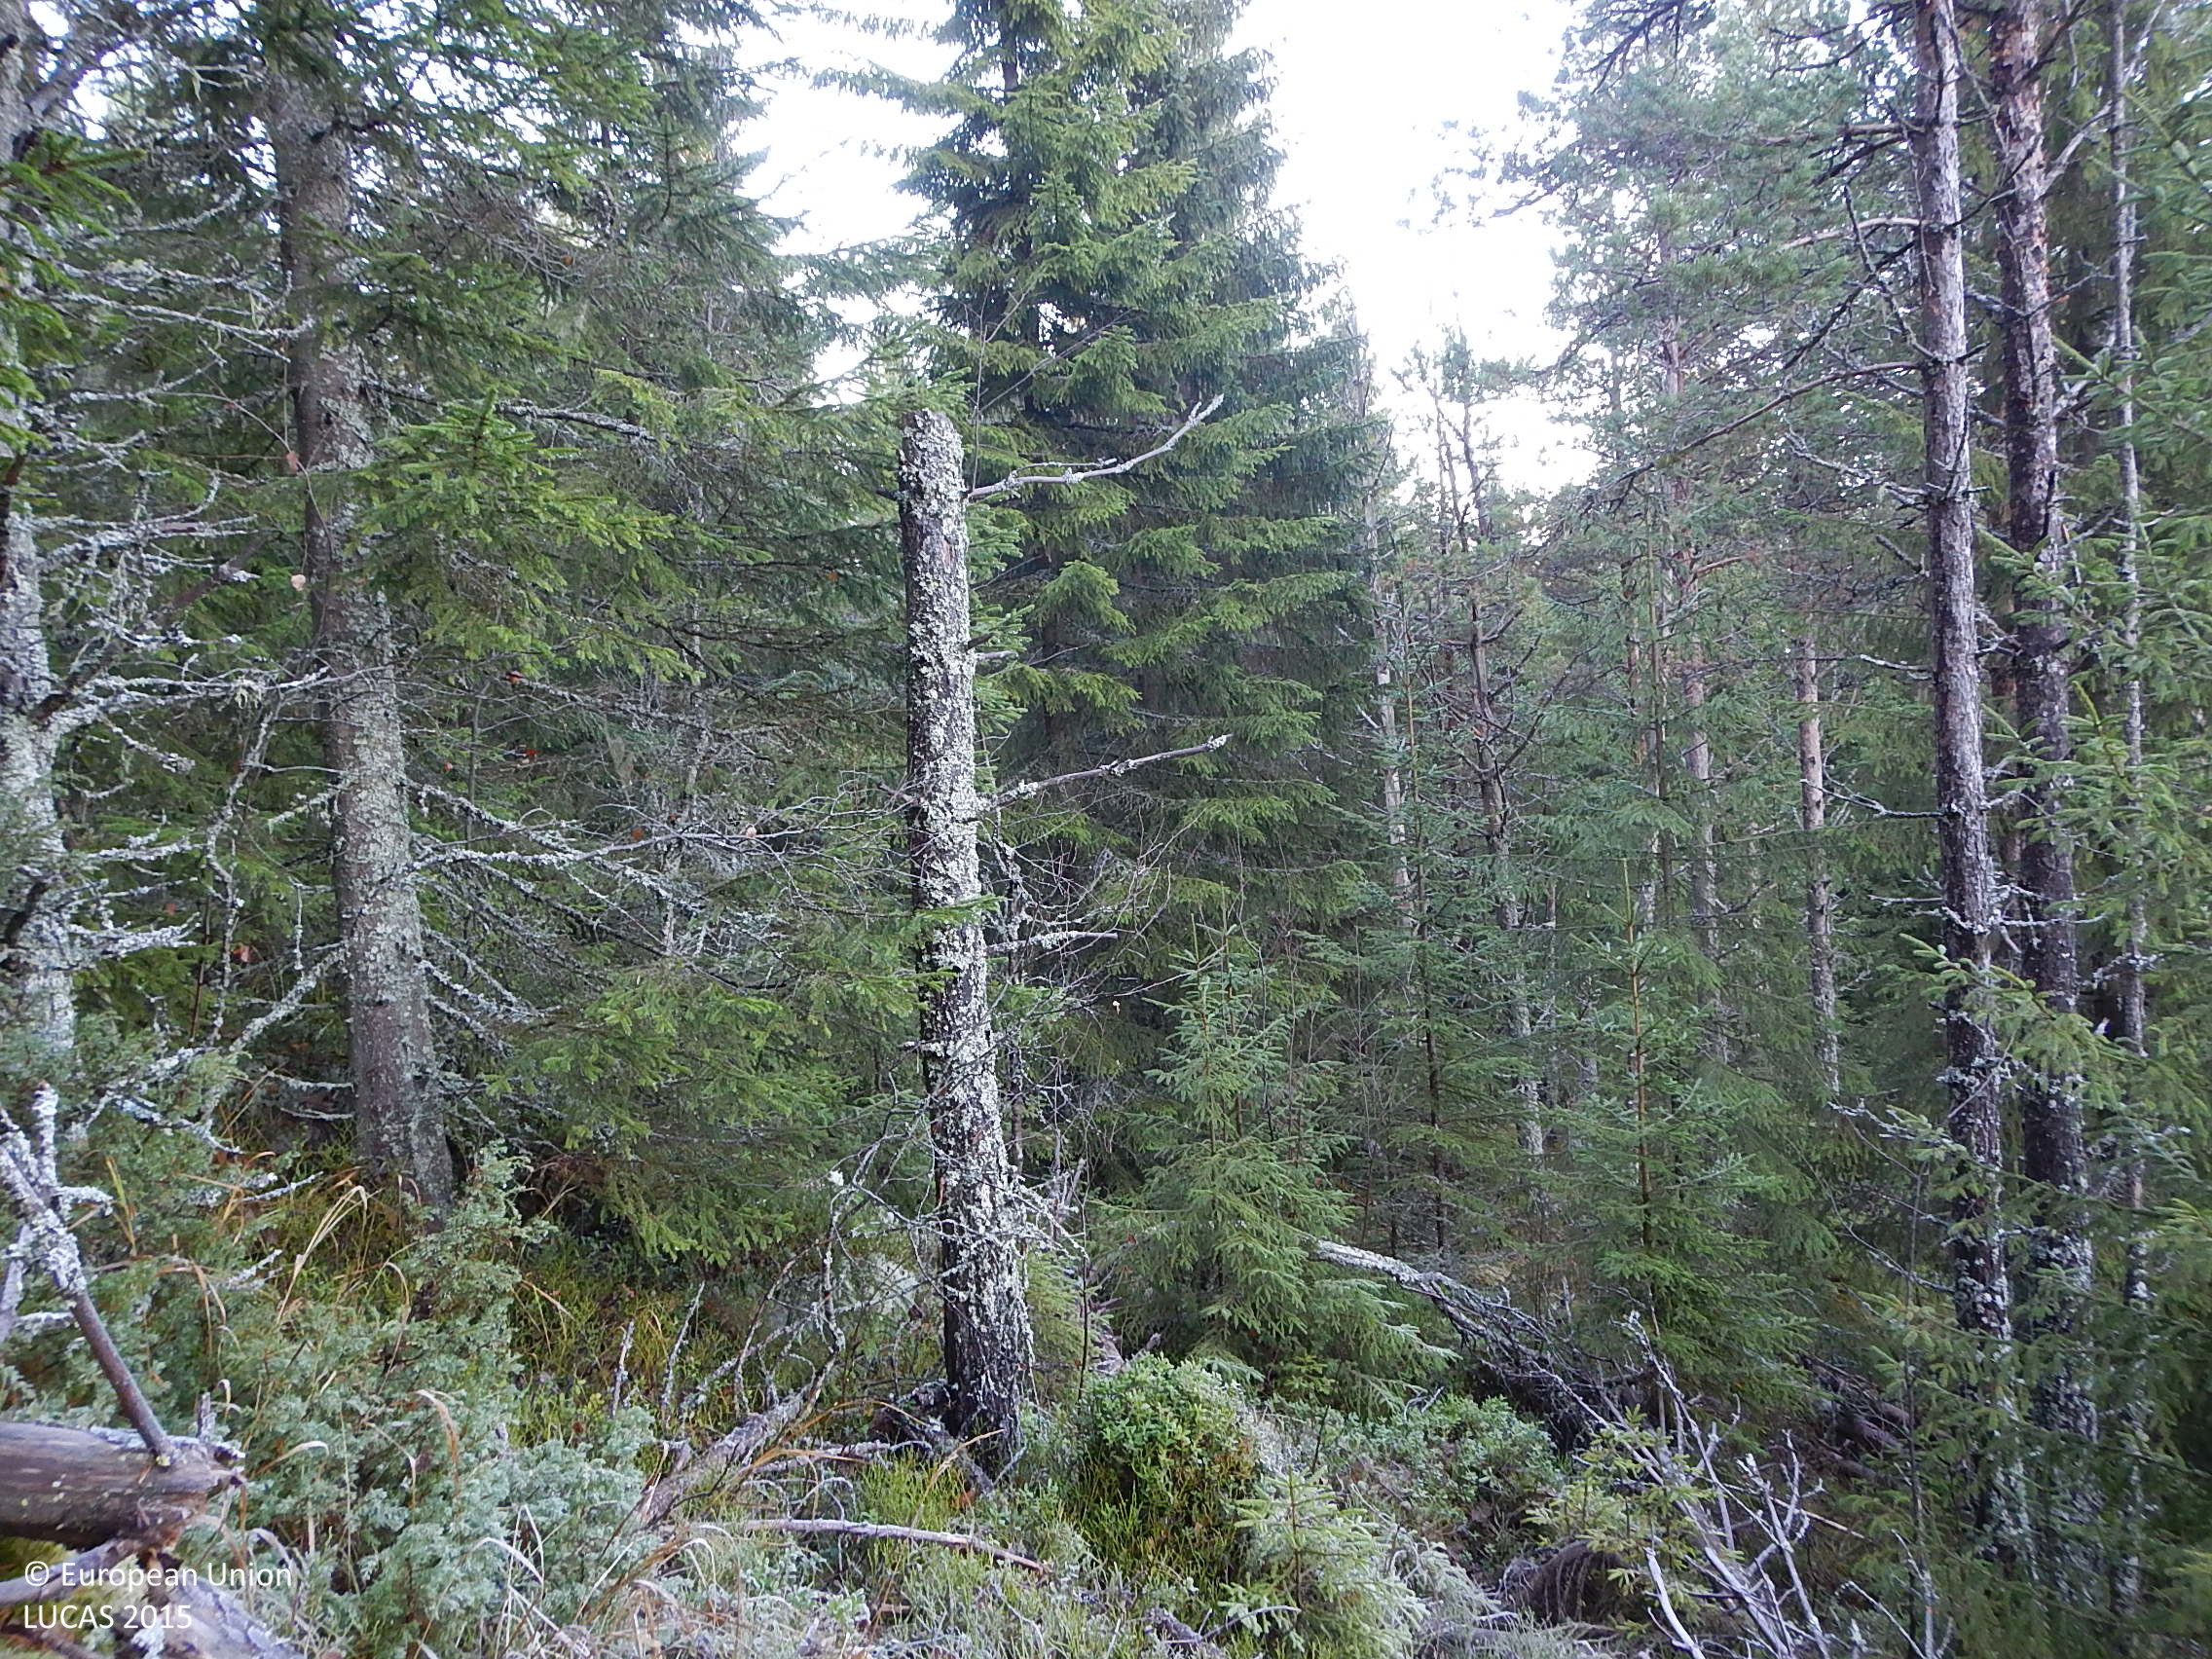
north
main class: Woodland
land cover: Other coniferous woodland
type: boreal forest
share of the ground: 50 - 75 %
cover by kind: coniferous forest trees 55 %, shrubs 30 %, broadleaved forest trees 5 %, herbaceous plants 5 %, lichens and mosses 5 %
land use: Forestry
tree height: > 5 m
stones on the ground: < 10 %
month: November
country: SE
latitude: 61.6770
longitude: 15.5947
